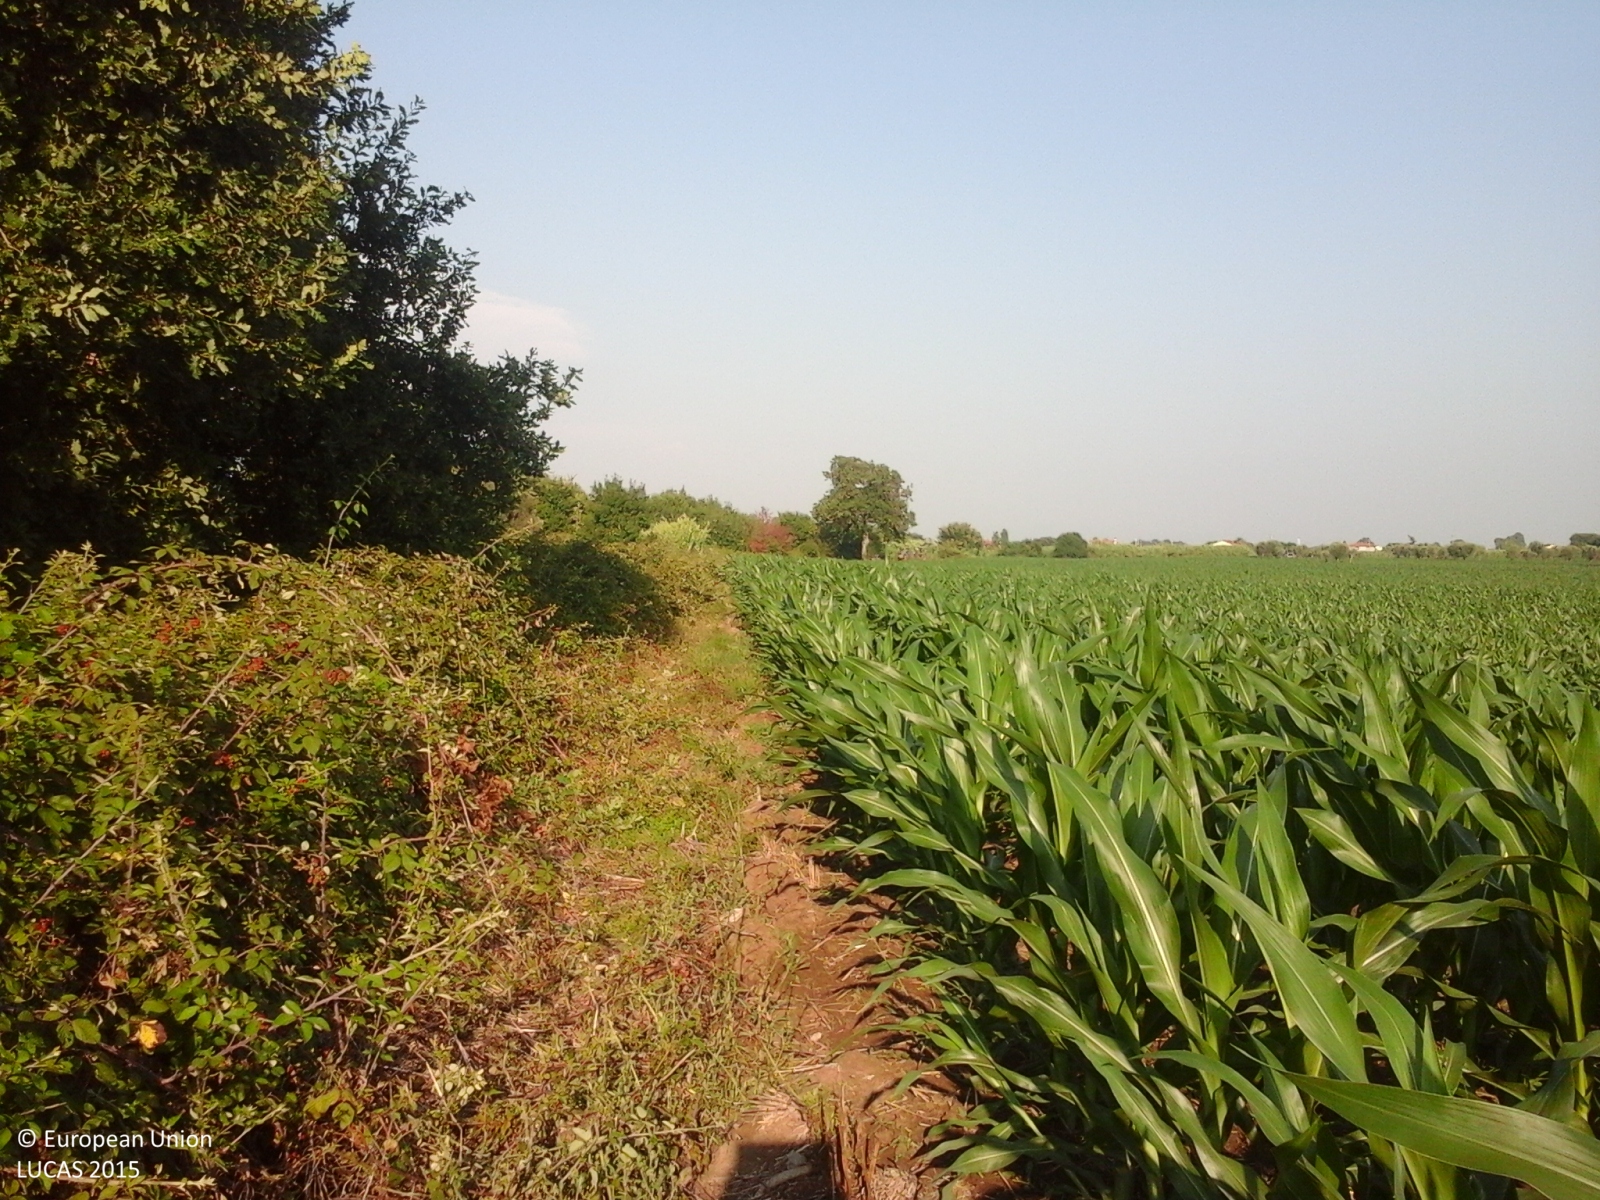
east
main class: Cropland
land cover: Maize
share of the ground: > 75 %
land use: Agriculture (excluding fallow land and kitchen gardens)
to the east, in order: Maize; Abandoned hedges; Maize; Tracks; Grassland without tree/shrub cover
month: July
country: IT
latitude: 41.5304
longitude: 12.8054
